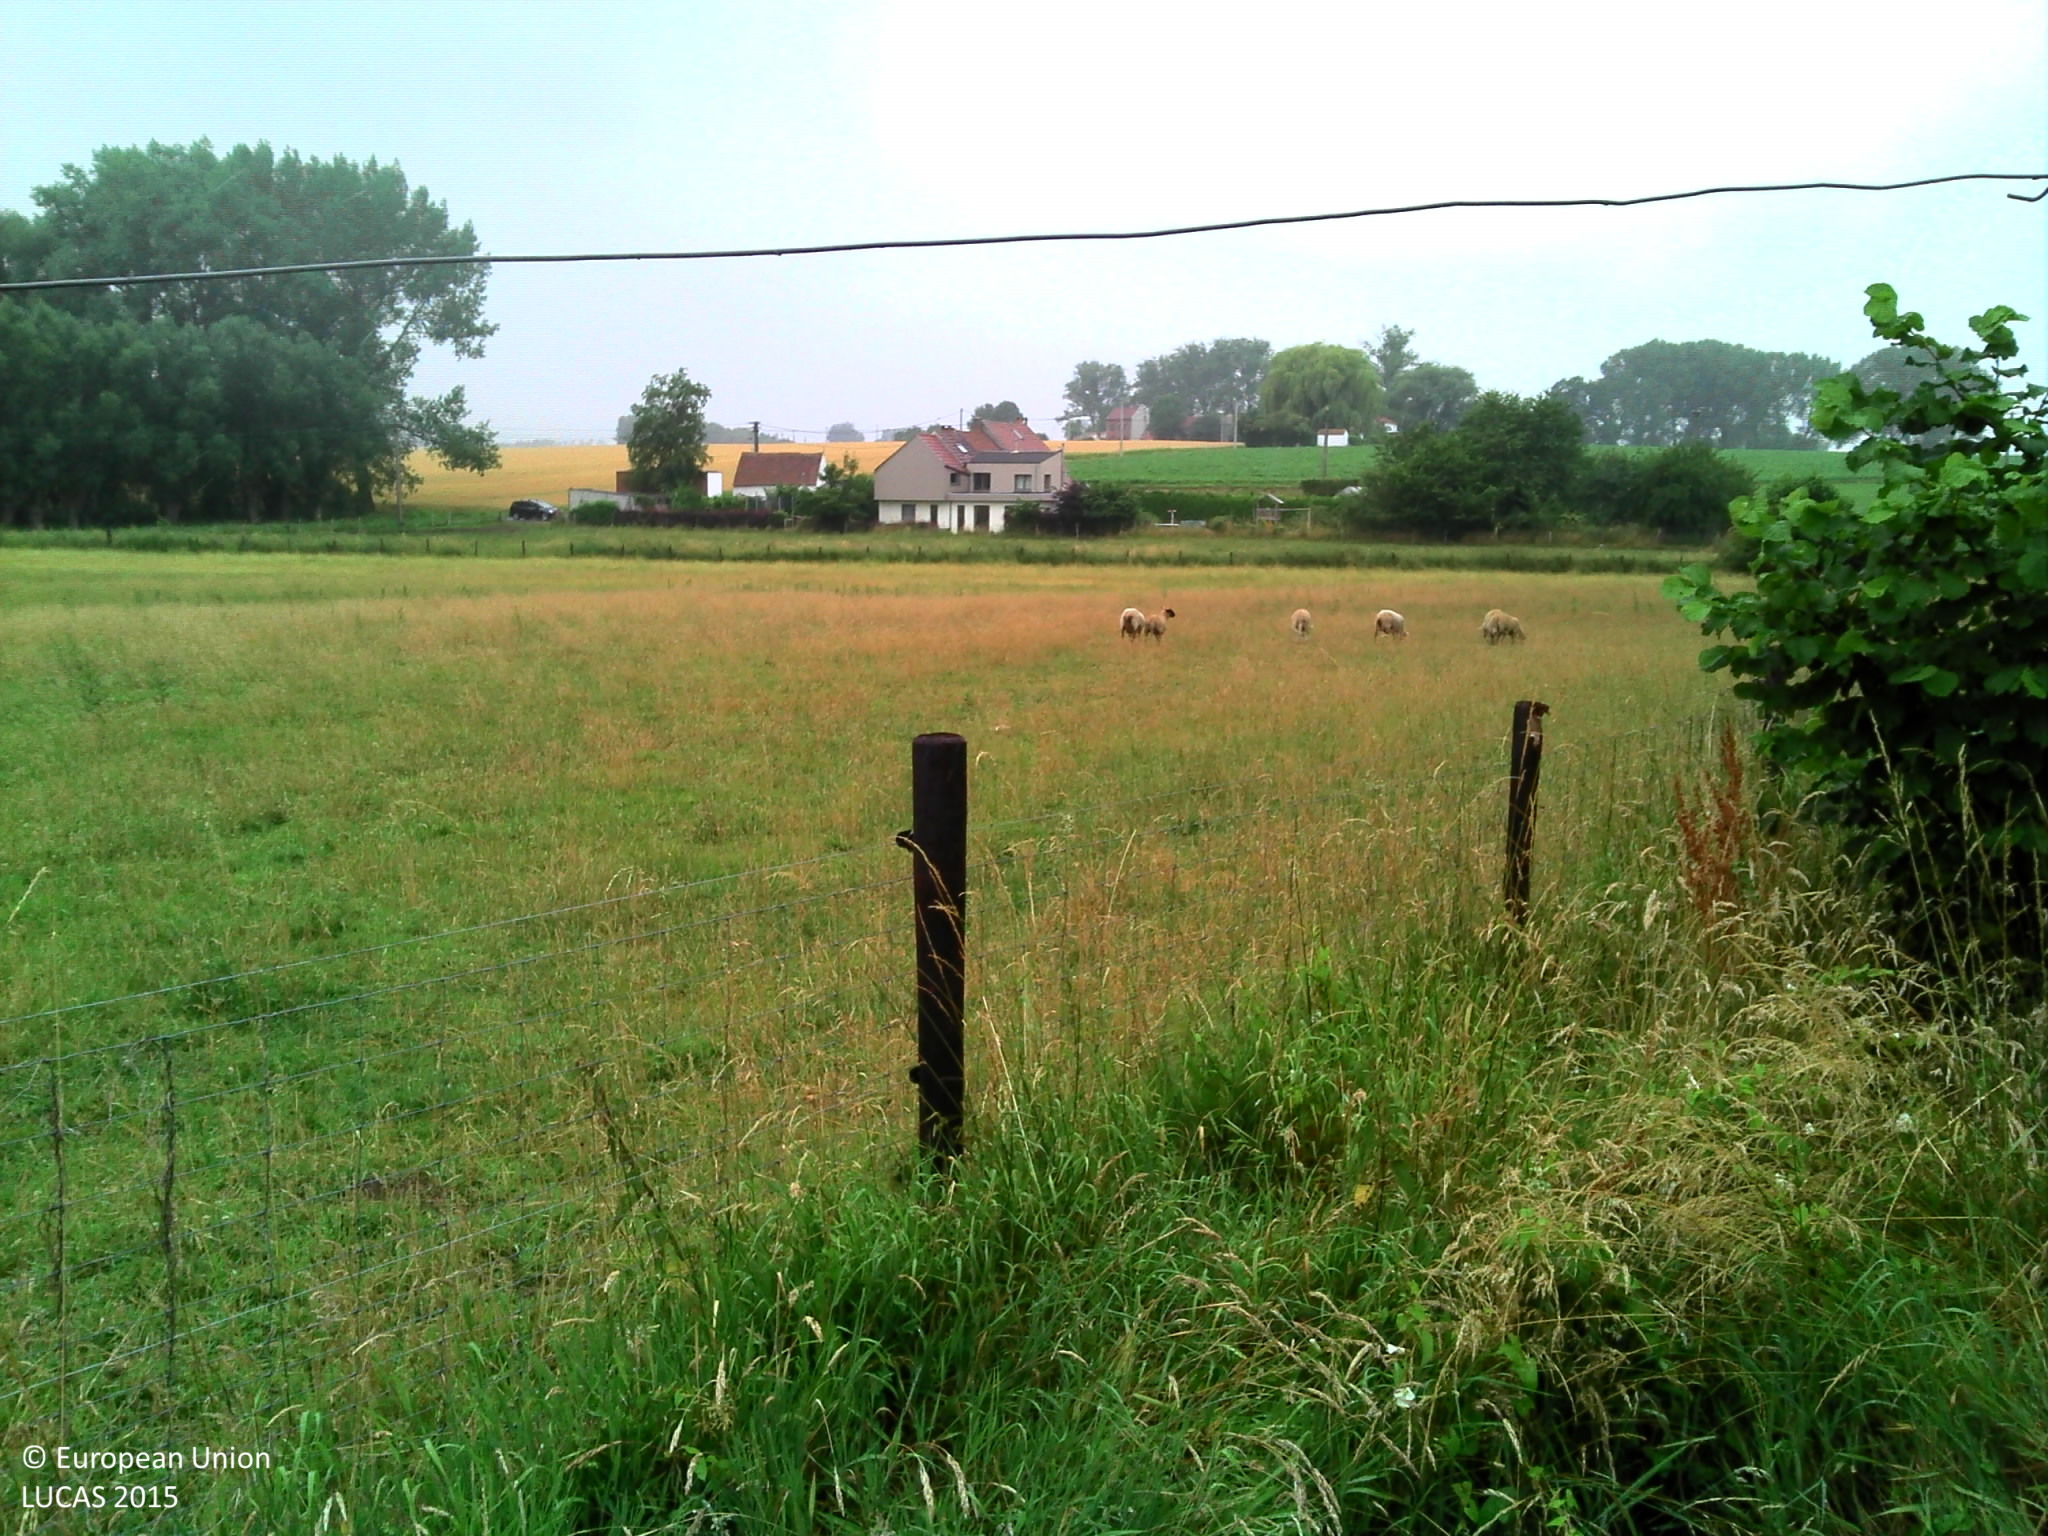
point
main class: Grassland
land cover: Grassland without tree/shrub cover
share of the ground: > 75 %
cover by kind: herbaceous plants 100 %
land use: Agriculture (excluding fallow land and kitchen gardens)
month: July
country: BE
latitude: 50.6085
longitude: 4.1020
